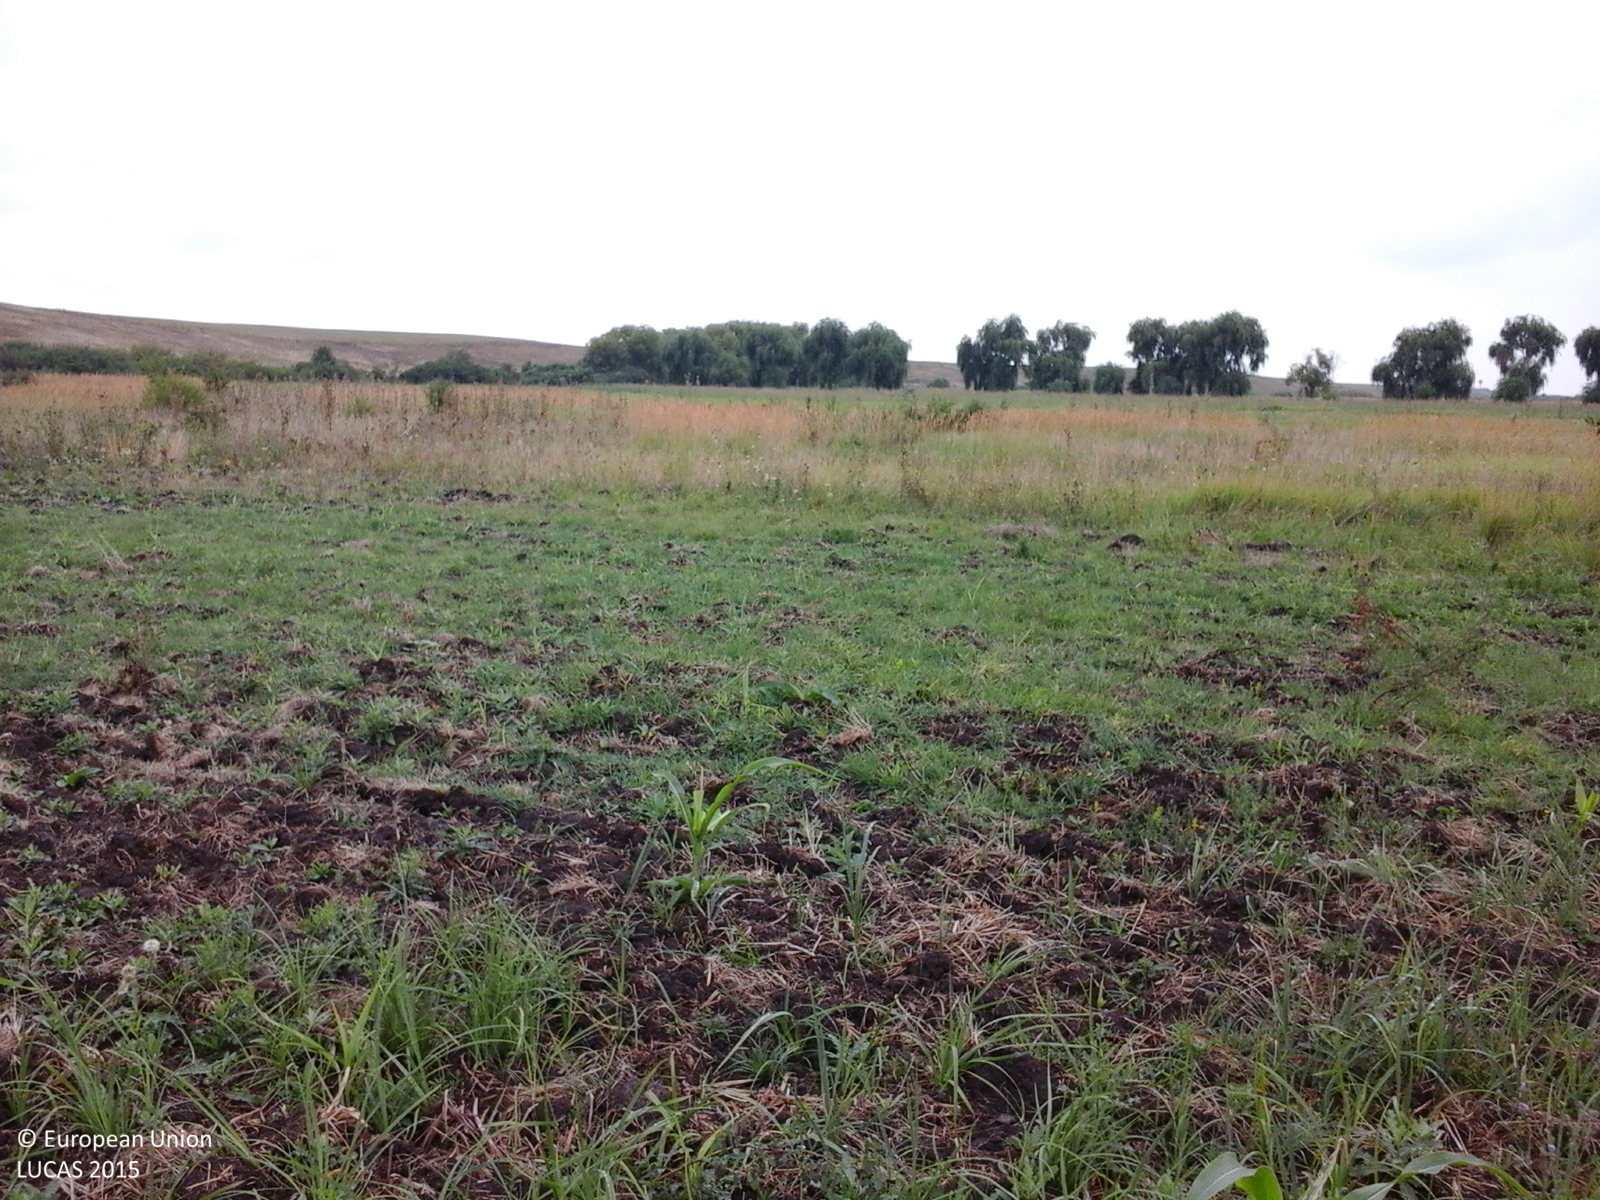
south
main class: Cropland
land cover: Maize
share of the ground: 10 - 25 %
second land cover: Spontaneously vegetated surfaces
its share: 25 - 50 %
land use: Agriculture (excluding fallow land and kitchen gardens)
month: August
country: RO
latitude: 45.9071
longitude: 21.3641
